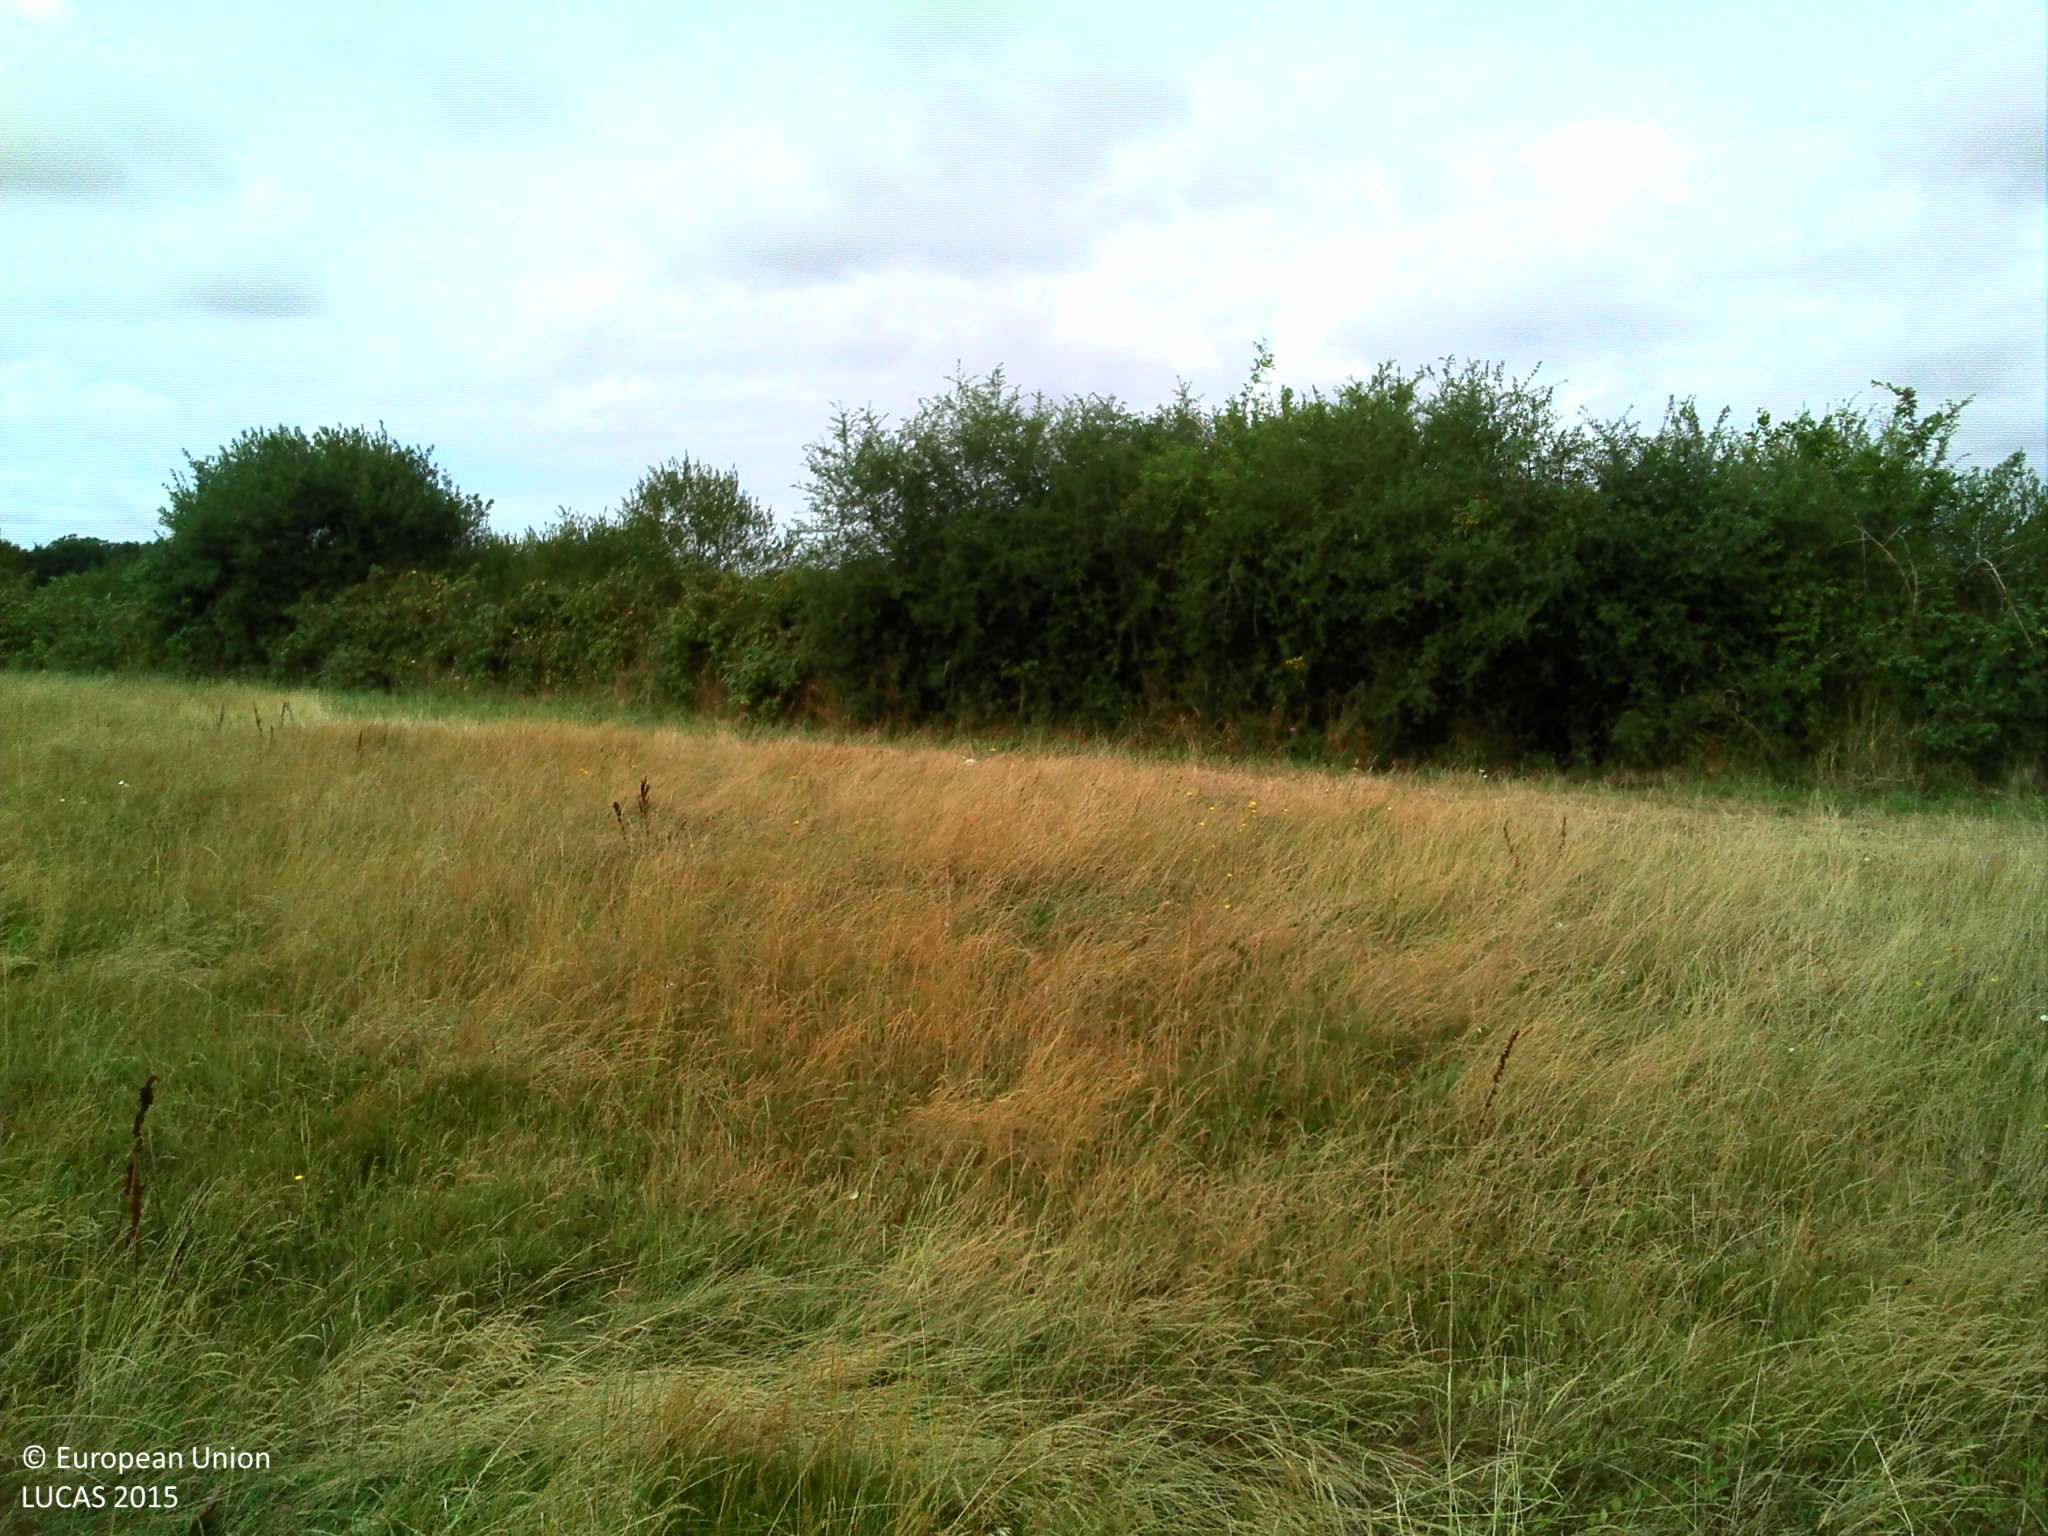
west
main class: Cropland
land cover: Temporary grasslands
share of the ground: > 75 %
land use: Agriculture (excluding fallow land and kitchen gardens)
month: July
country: FR
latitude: 47.4500
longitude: -1.8914
